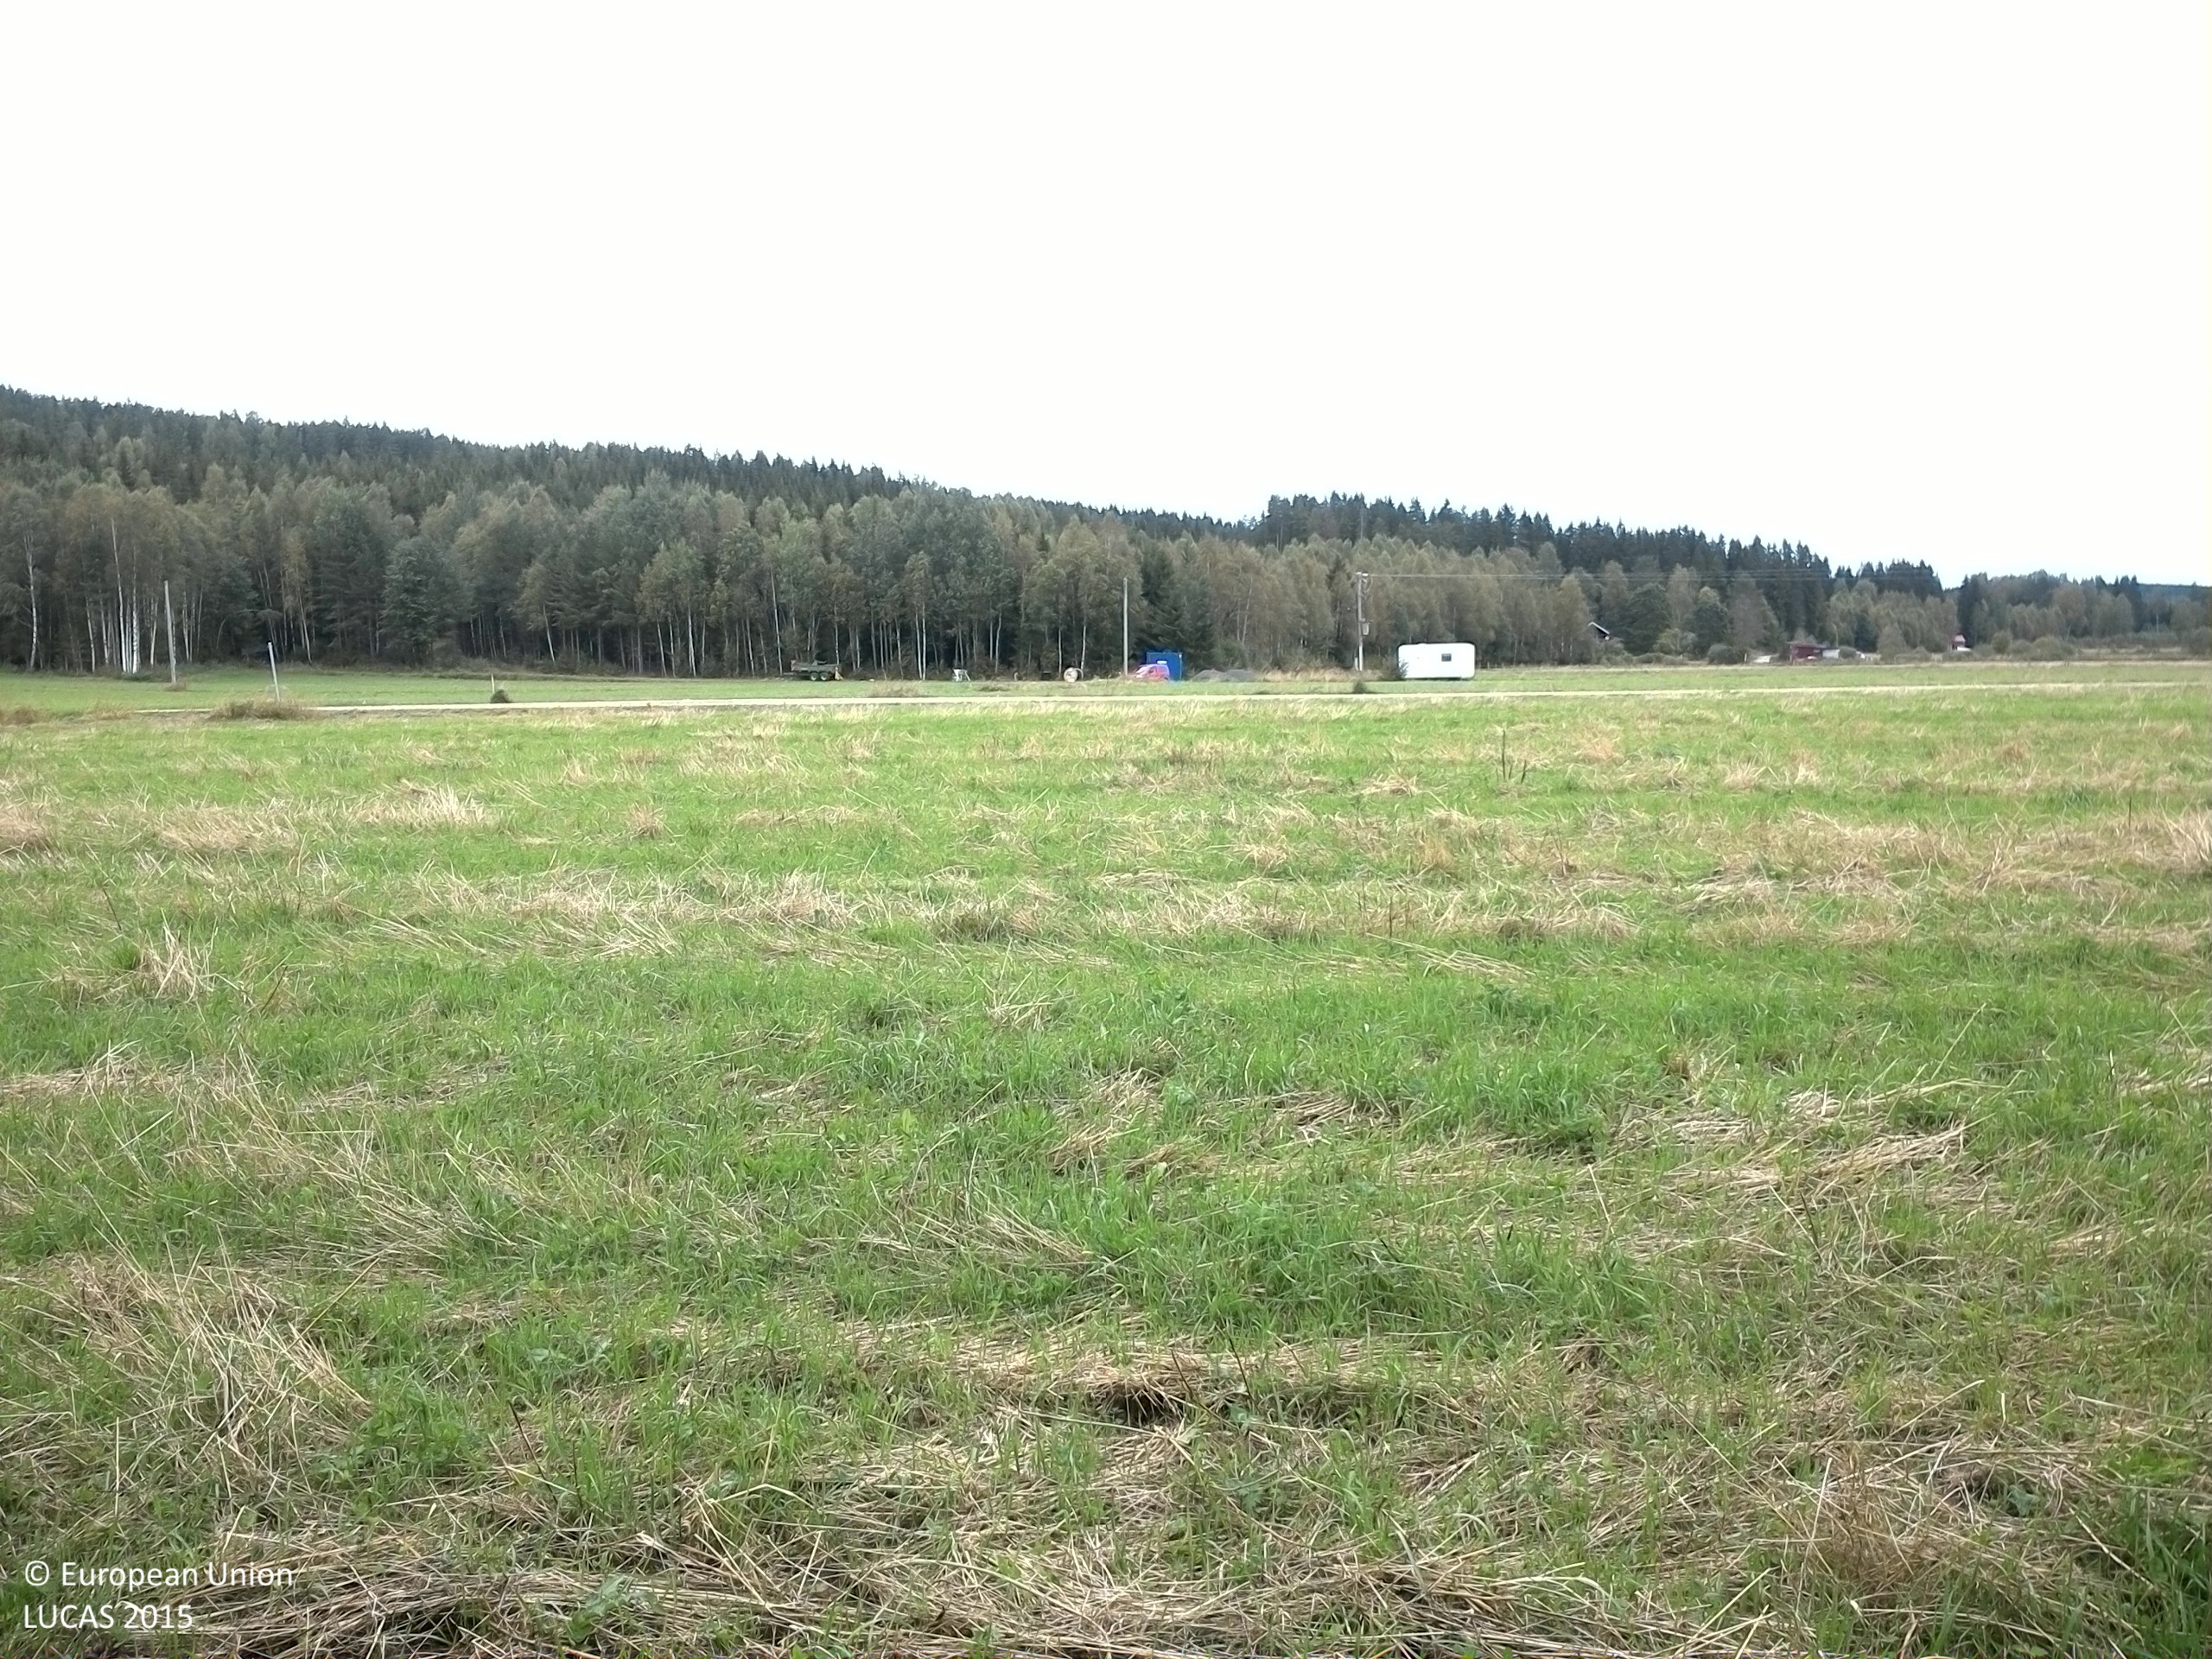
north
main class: Grassland
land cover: Grassland without tree/shrub cover
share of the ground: > 75 %
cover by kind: herbaceous plants 90 %, consolidated bare surface 10 %
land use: Agriculture (excluding fallow land and kitchen gardens)
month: September
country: SE
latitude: 59.8317
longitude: 13.4700
